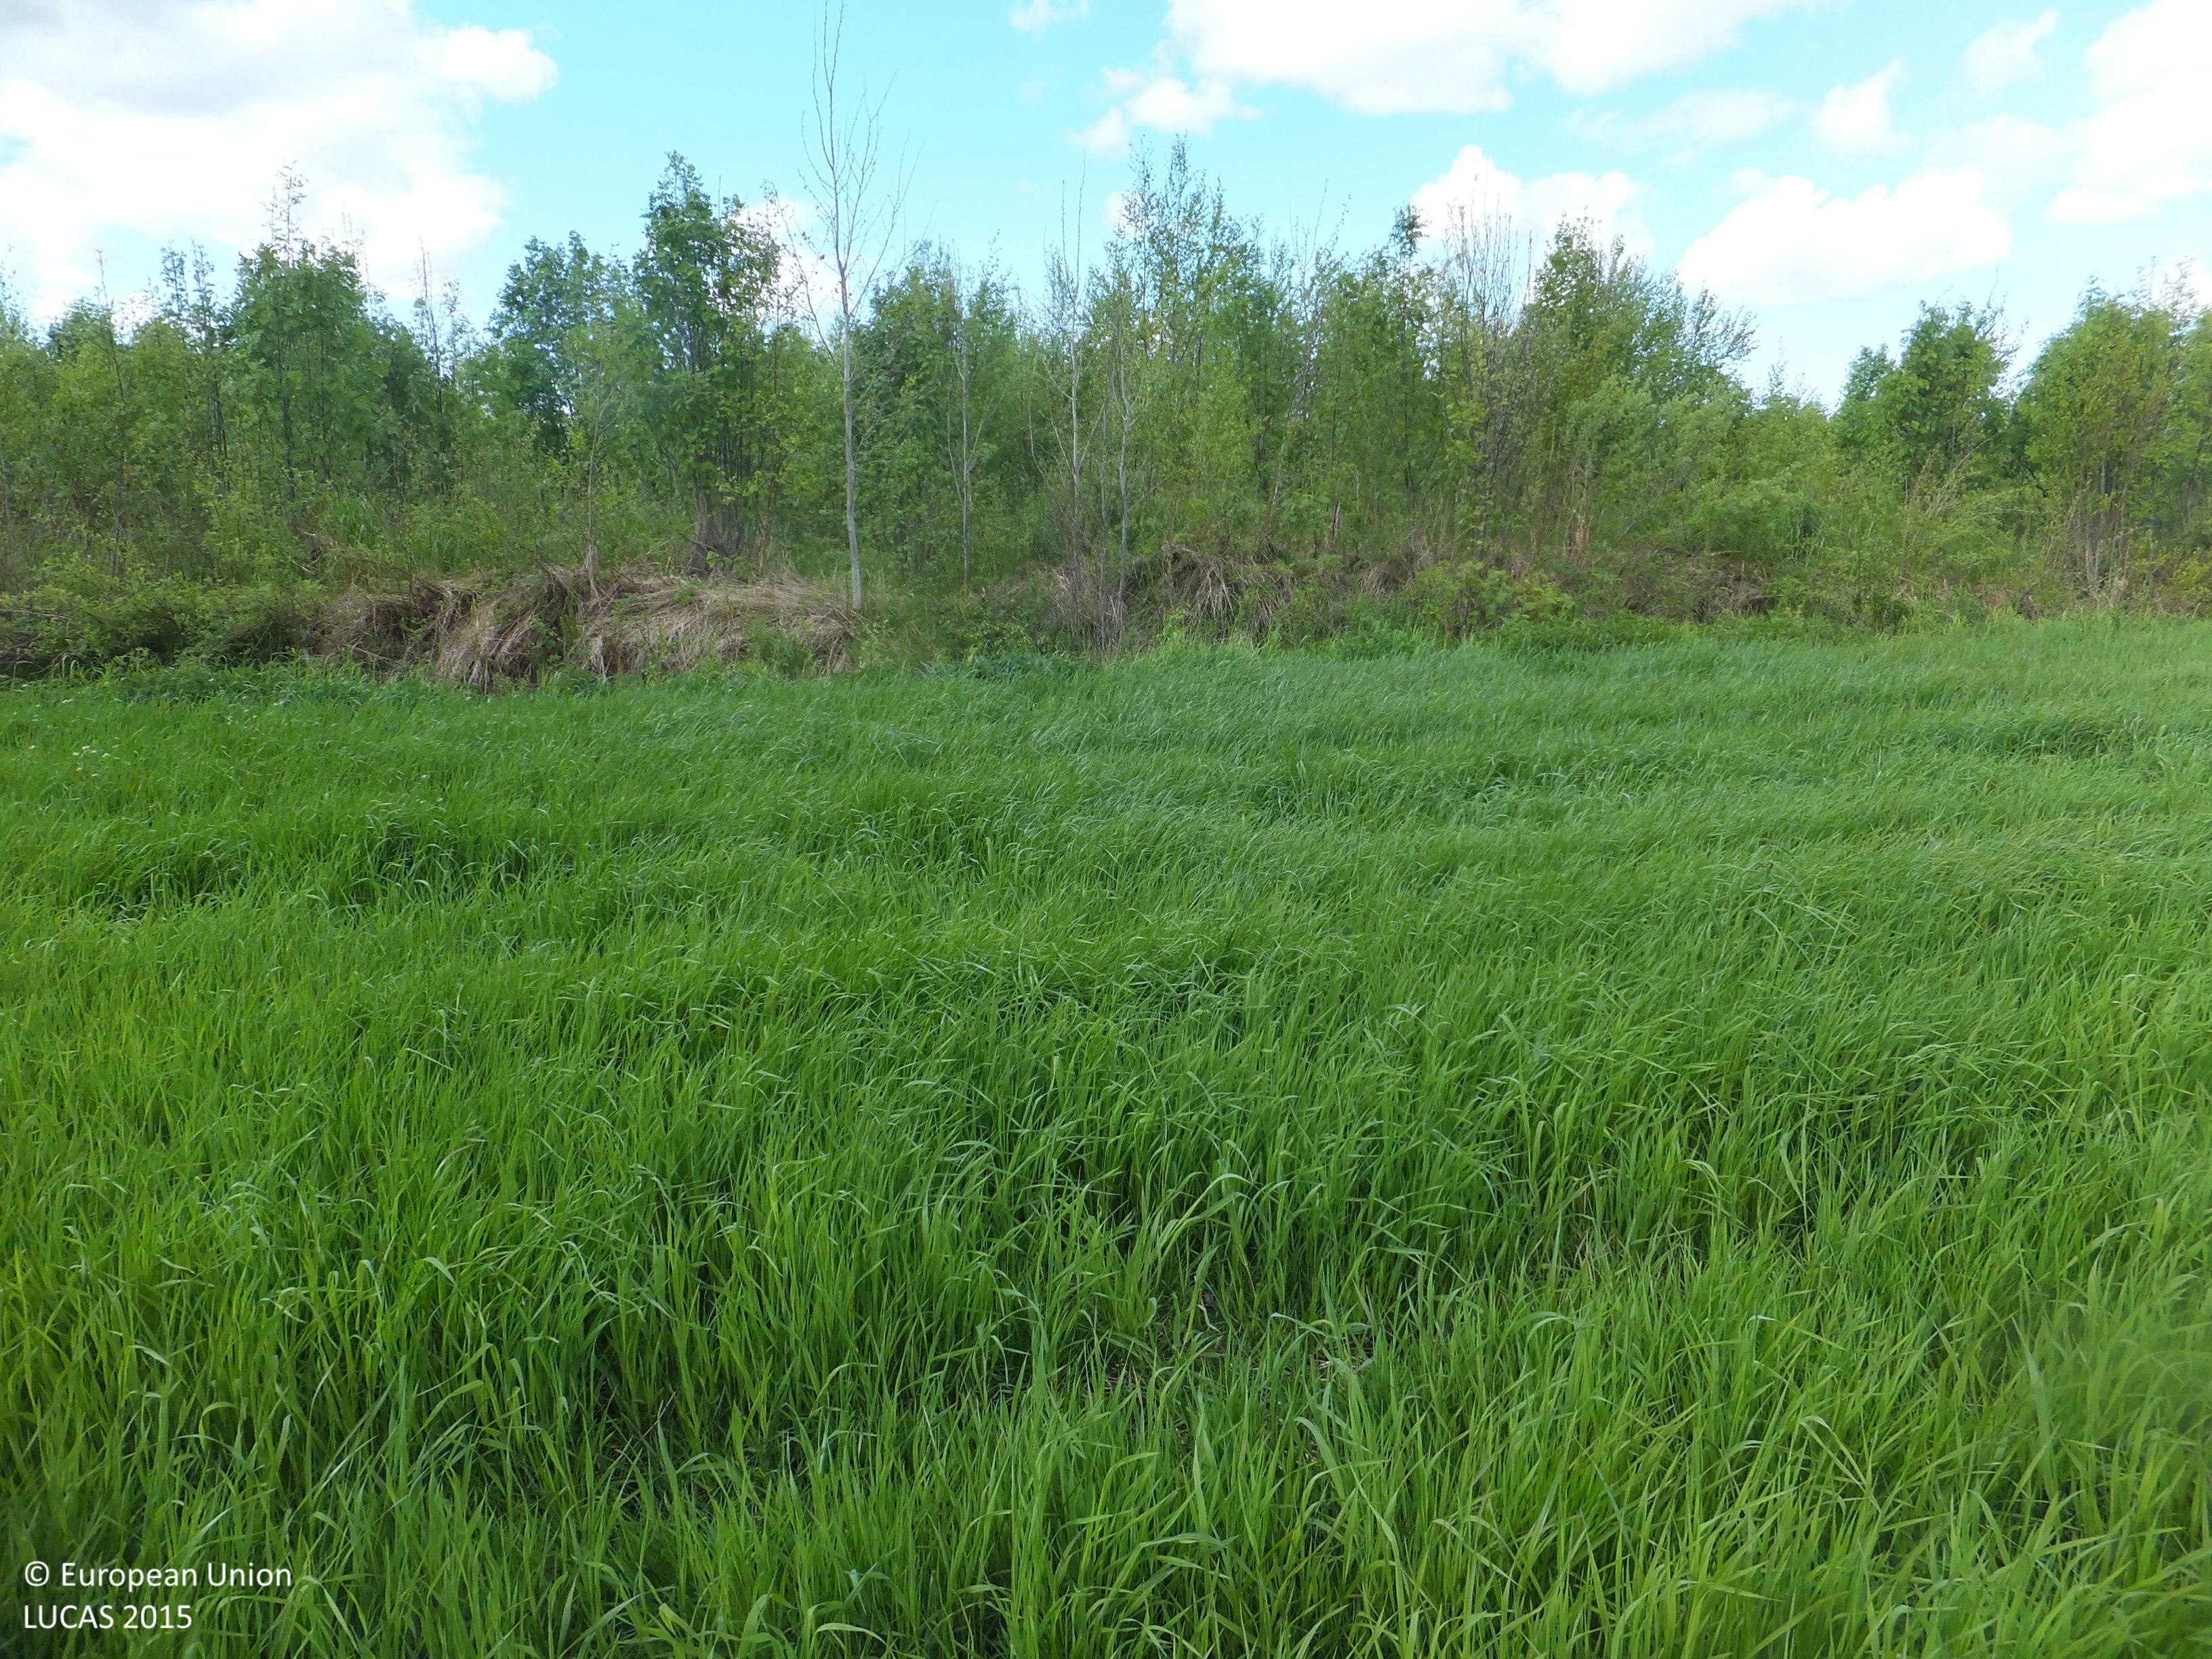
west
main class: Cropland
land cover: Temporary grasslands
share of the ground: > 75 %
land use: Agriculture (excluding fallow land and kitchen gardens)
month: June
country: FI
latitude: 63.5815
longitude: 23.0478
